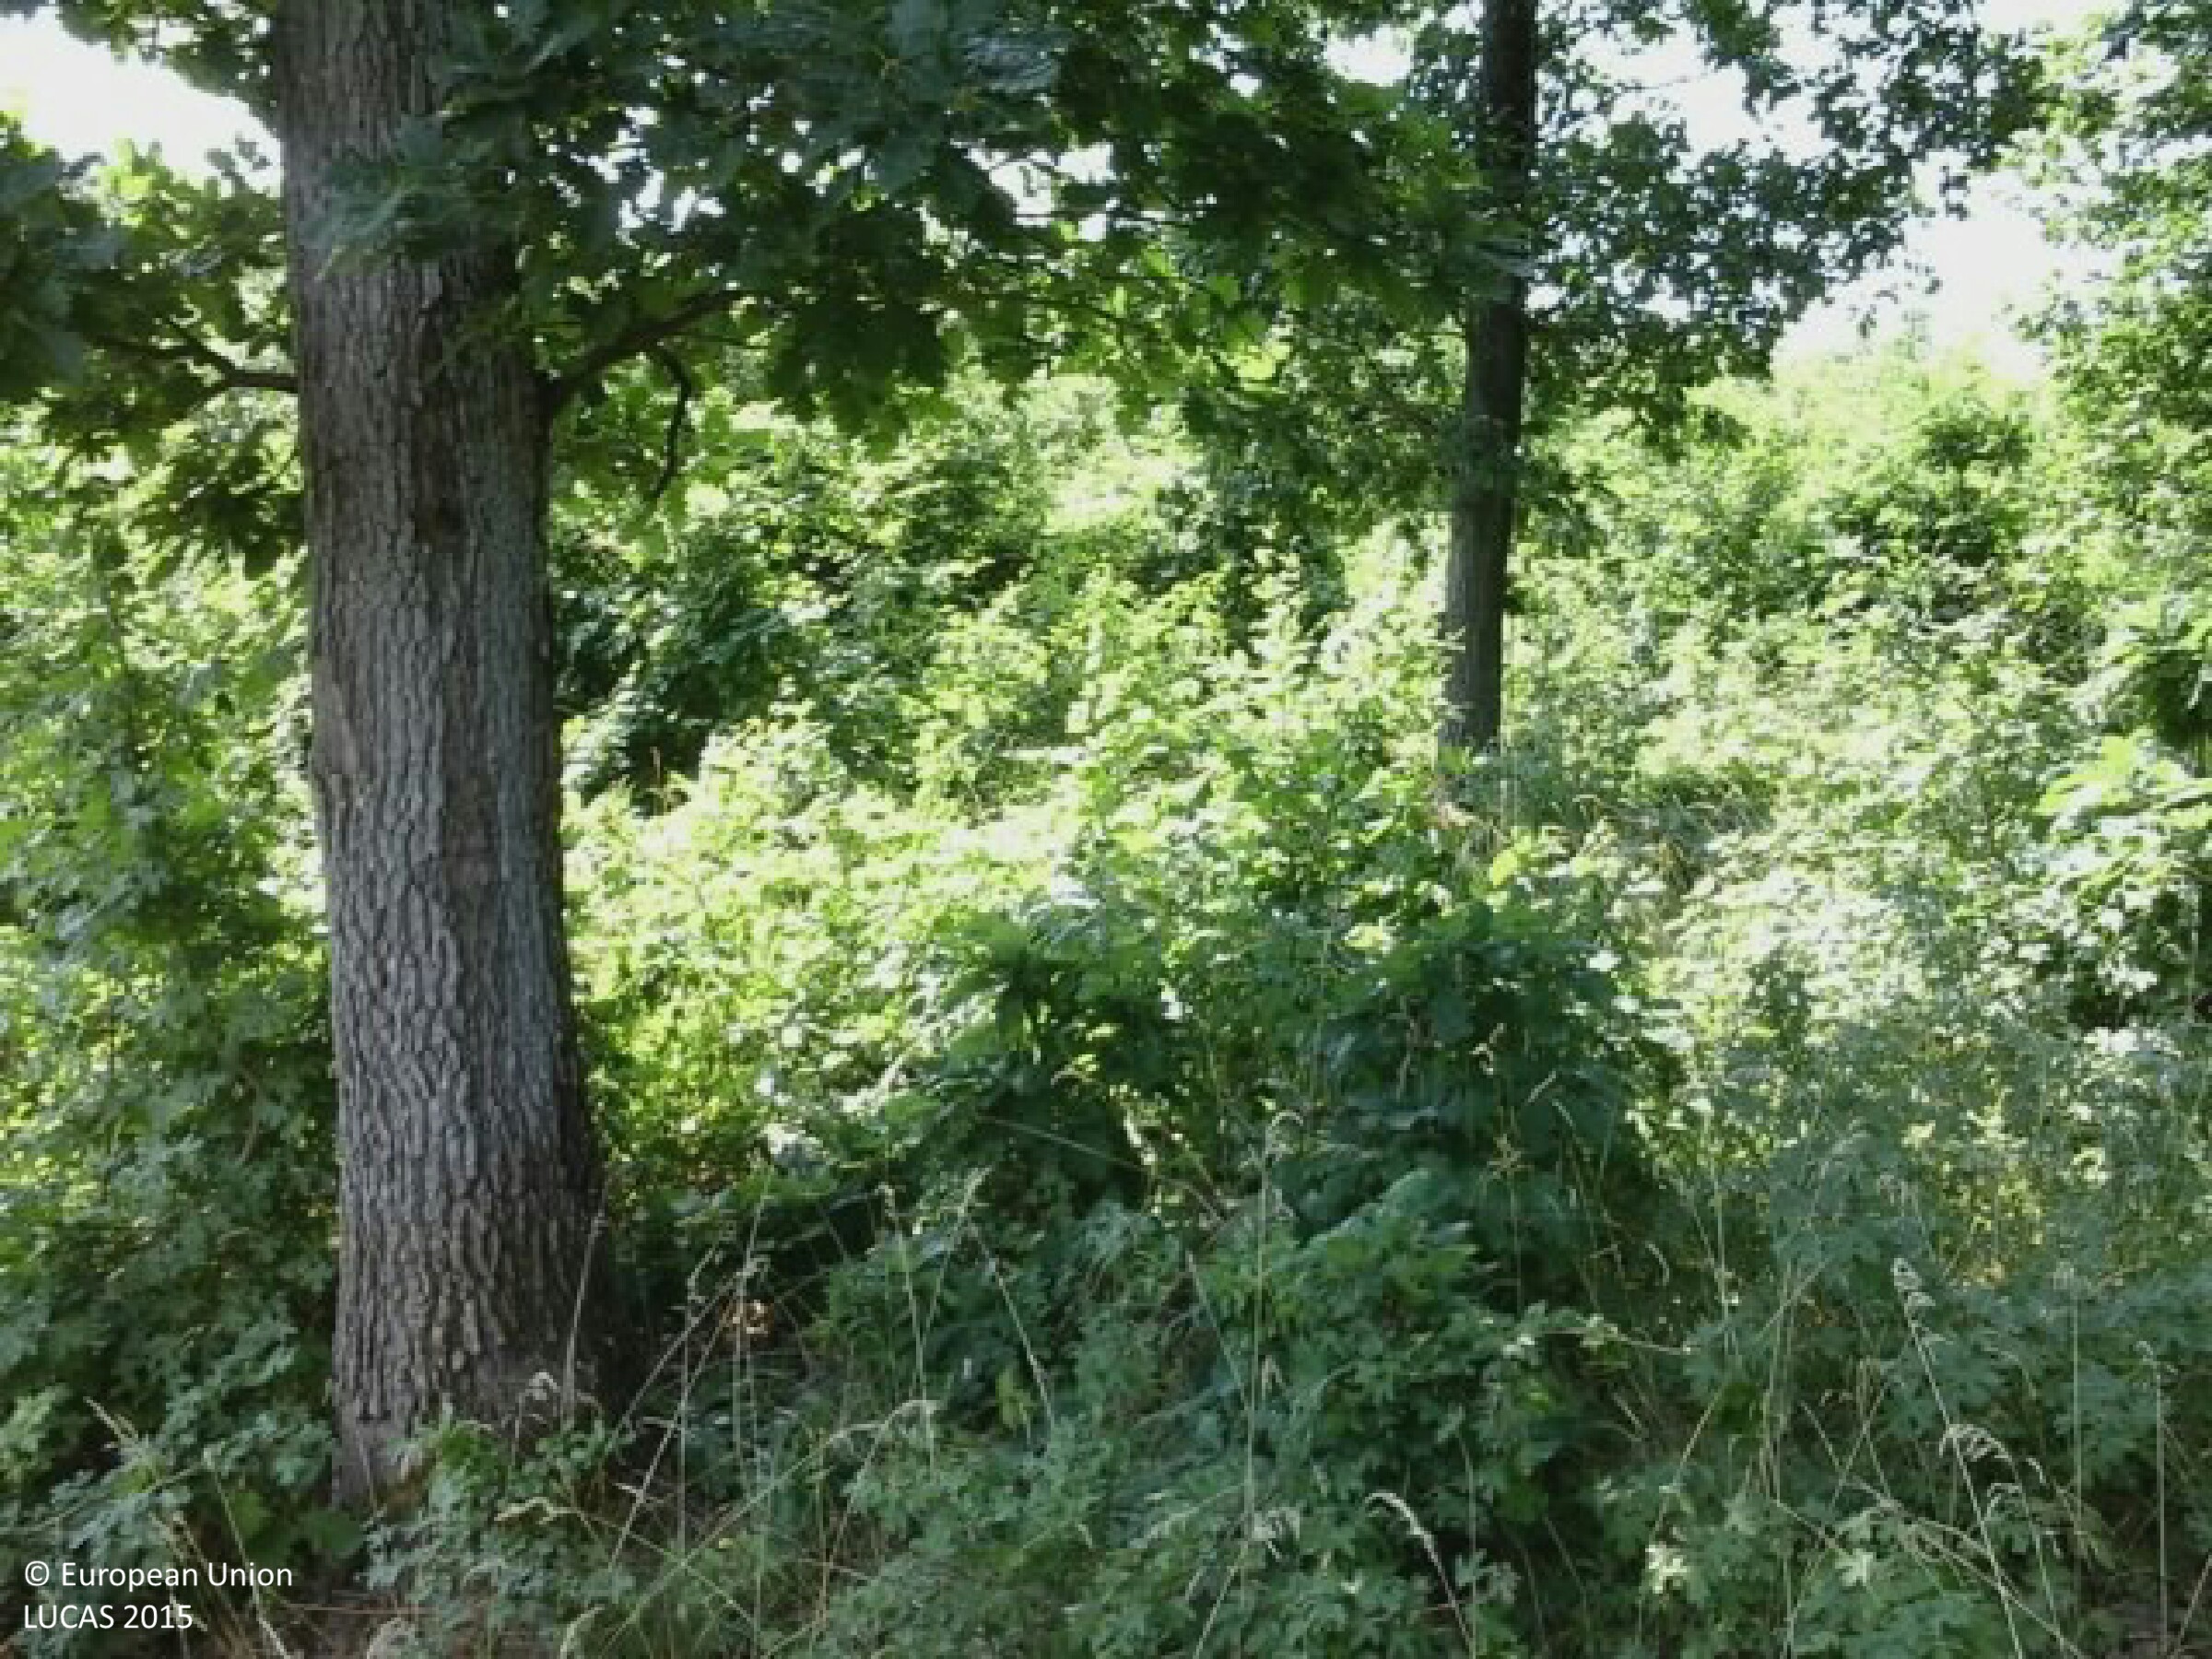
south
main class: Woodland
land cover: Broadleaved woodland
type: mesophytic deciduous forest
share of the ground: > 75 %
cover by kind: broadleaved forest trees 100 %
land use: Forestry
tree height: < 5 m
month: July
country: HU
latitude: 47.7355
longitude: 19.3420
